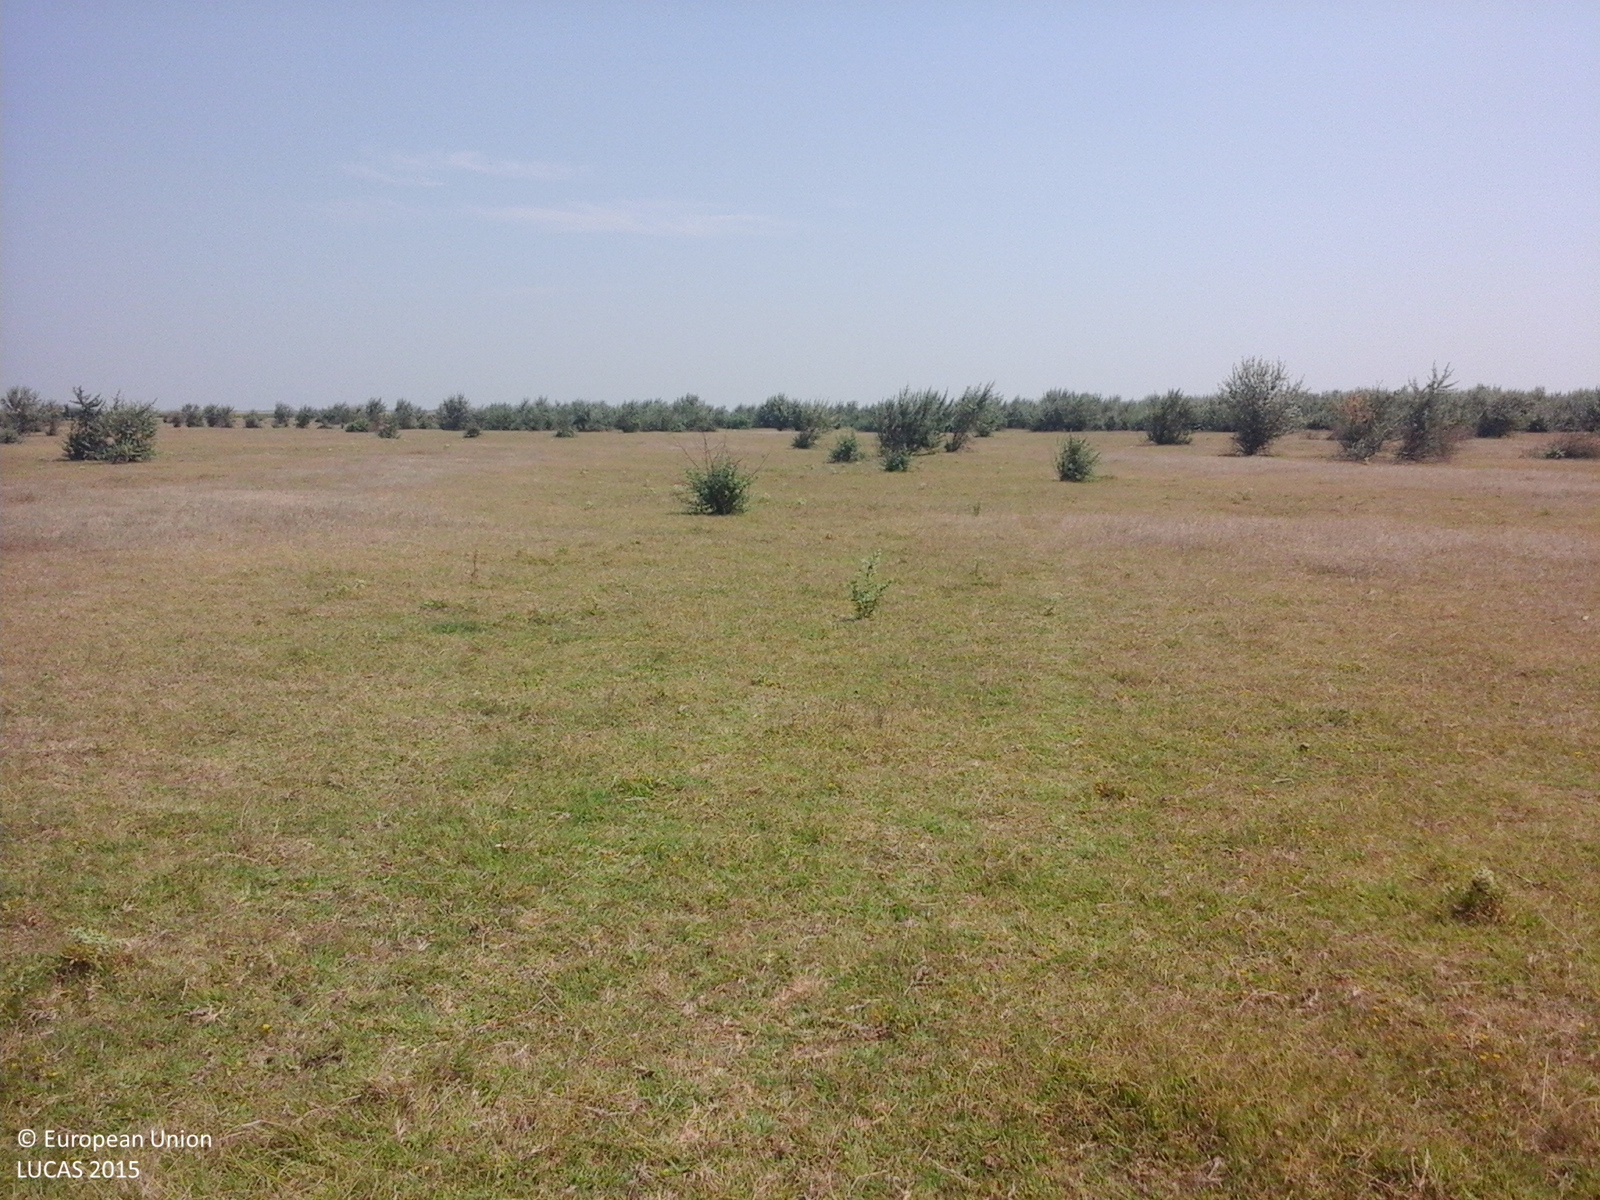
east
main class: Grassland
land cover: Grassland without tree/shrub cover
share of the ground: > 75 %
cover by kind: herbaceous plants 100 %
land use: Agriculture (excluding fallow land and kitchen gardens)
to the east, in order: Grassland without tree/shrub cover; Grassland with sparse tree/shrub cover; Ditches and canals; Shrubland without tree cover
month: August
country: RO
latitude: 45.1266
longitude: 27.3210
